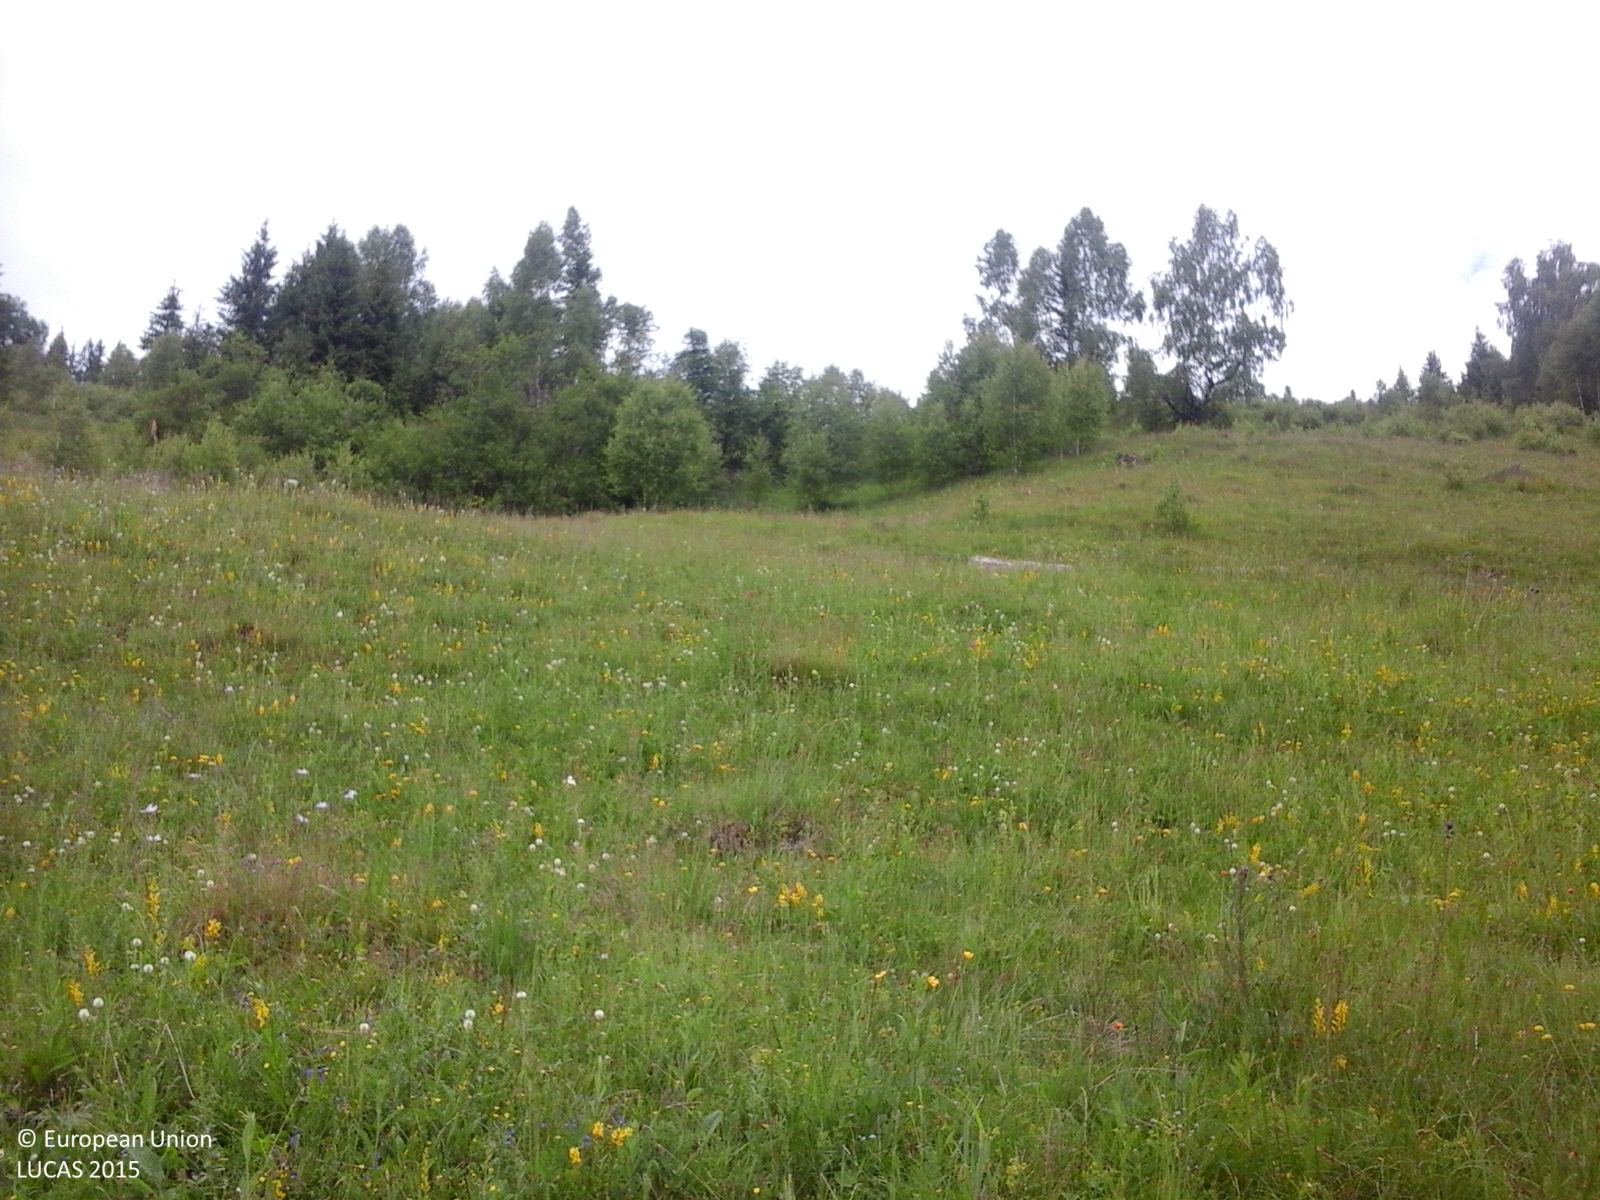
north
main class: Grassland
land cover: Grassland without tree/shrub cover
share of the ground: > 75 %
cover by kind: herbaceous plants 100 %
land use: Agriculture (excluding fallow land and kitchen gardens)
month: June
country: RO
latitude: 47.5262
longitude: 25.2108
